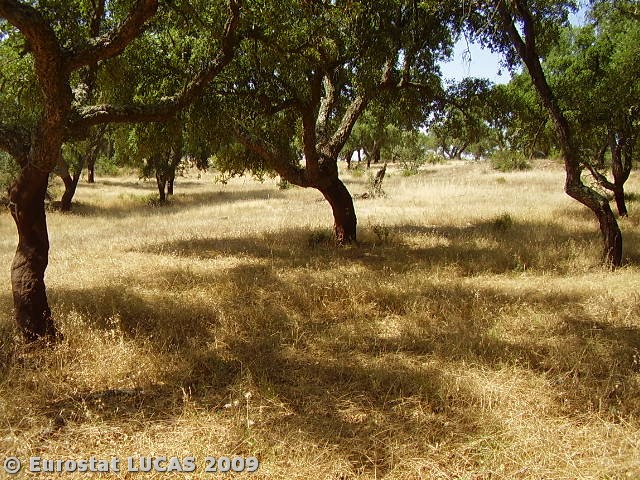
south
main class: Woodland
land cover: Broadleaved woodland
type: broadleaved evergreen forest
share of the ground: 50 - 75 %
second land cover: Spontaneously vegetated surfaces
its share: 25 - 50 %
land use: Forestry
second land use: Fallow land
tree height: > 5 m
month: June
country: PT
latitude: 38.7738
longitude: -7.9896
